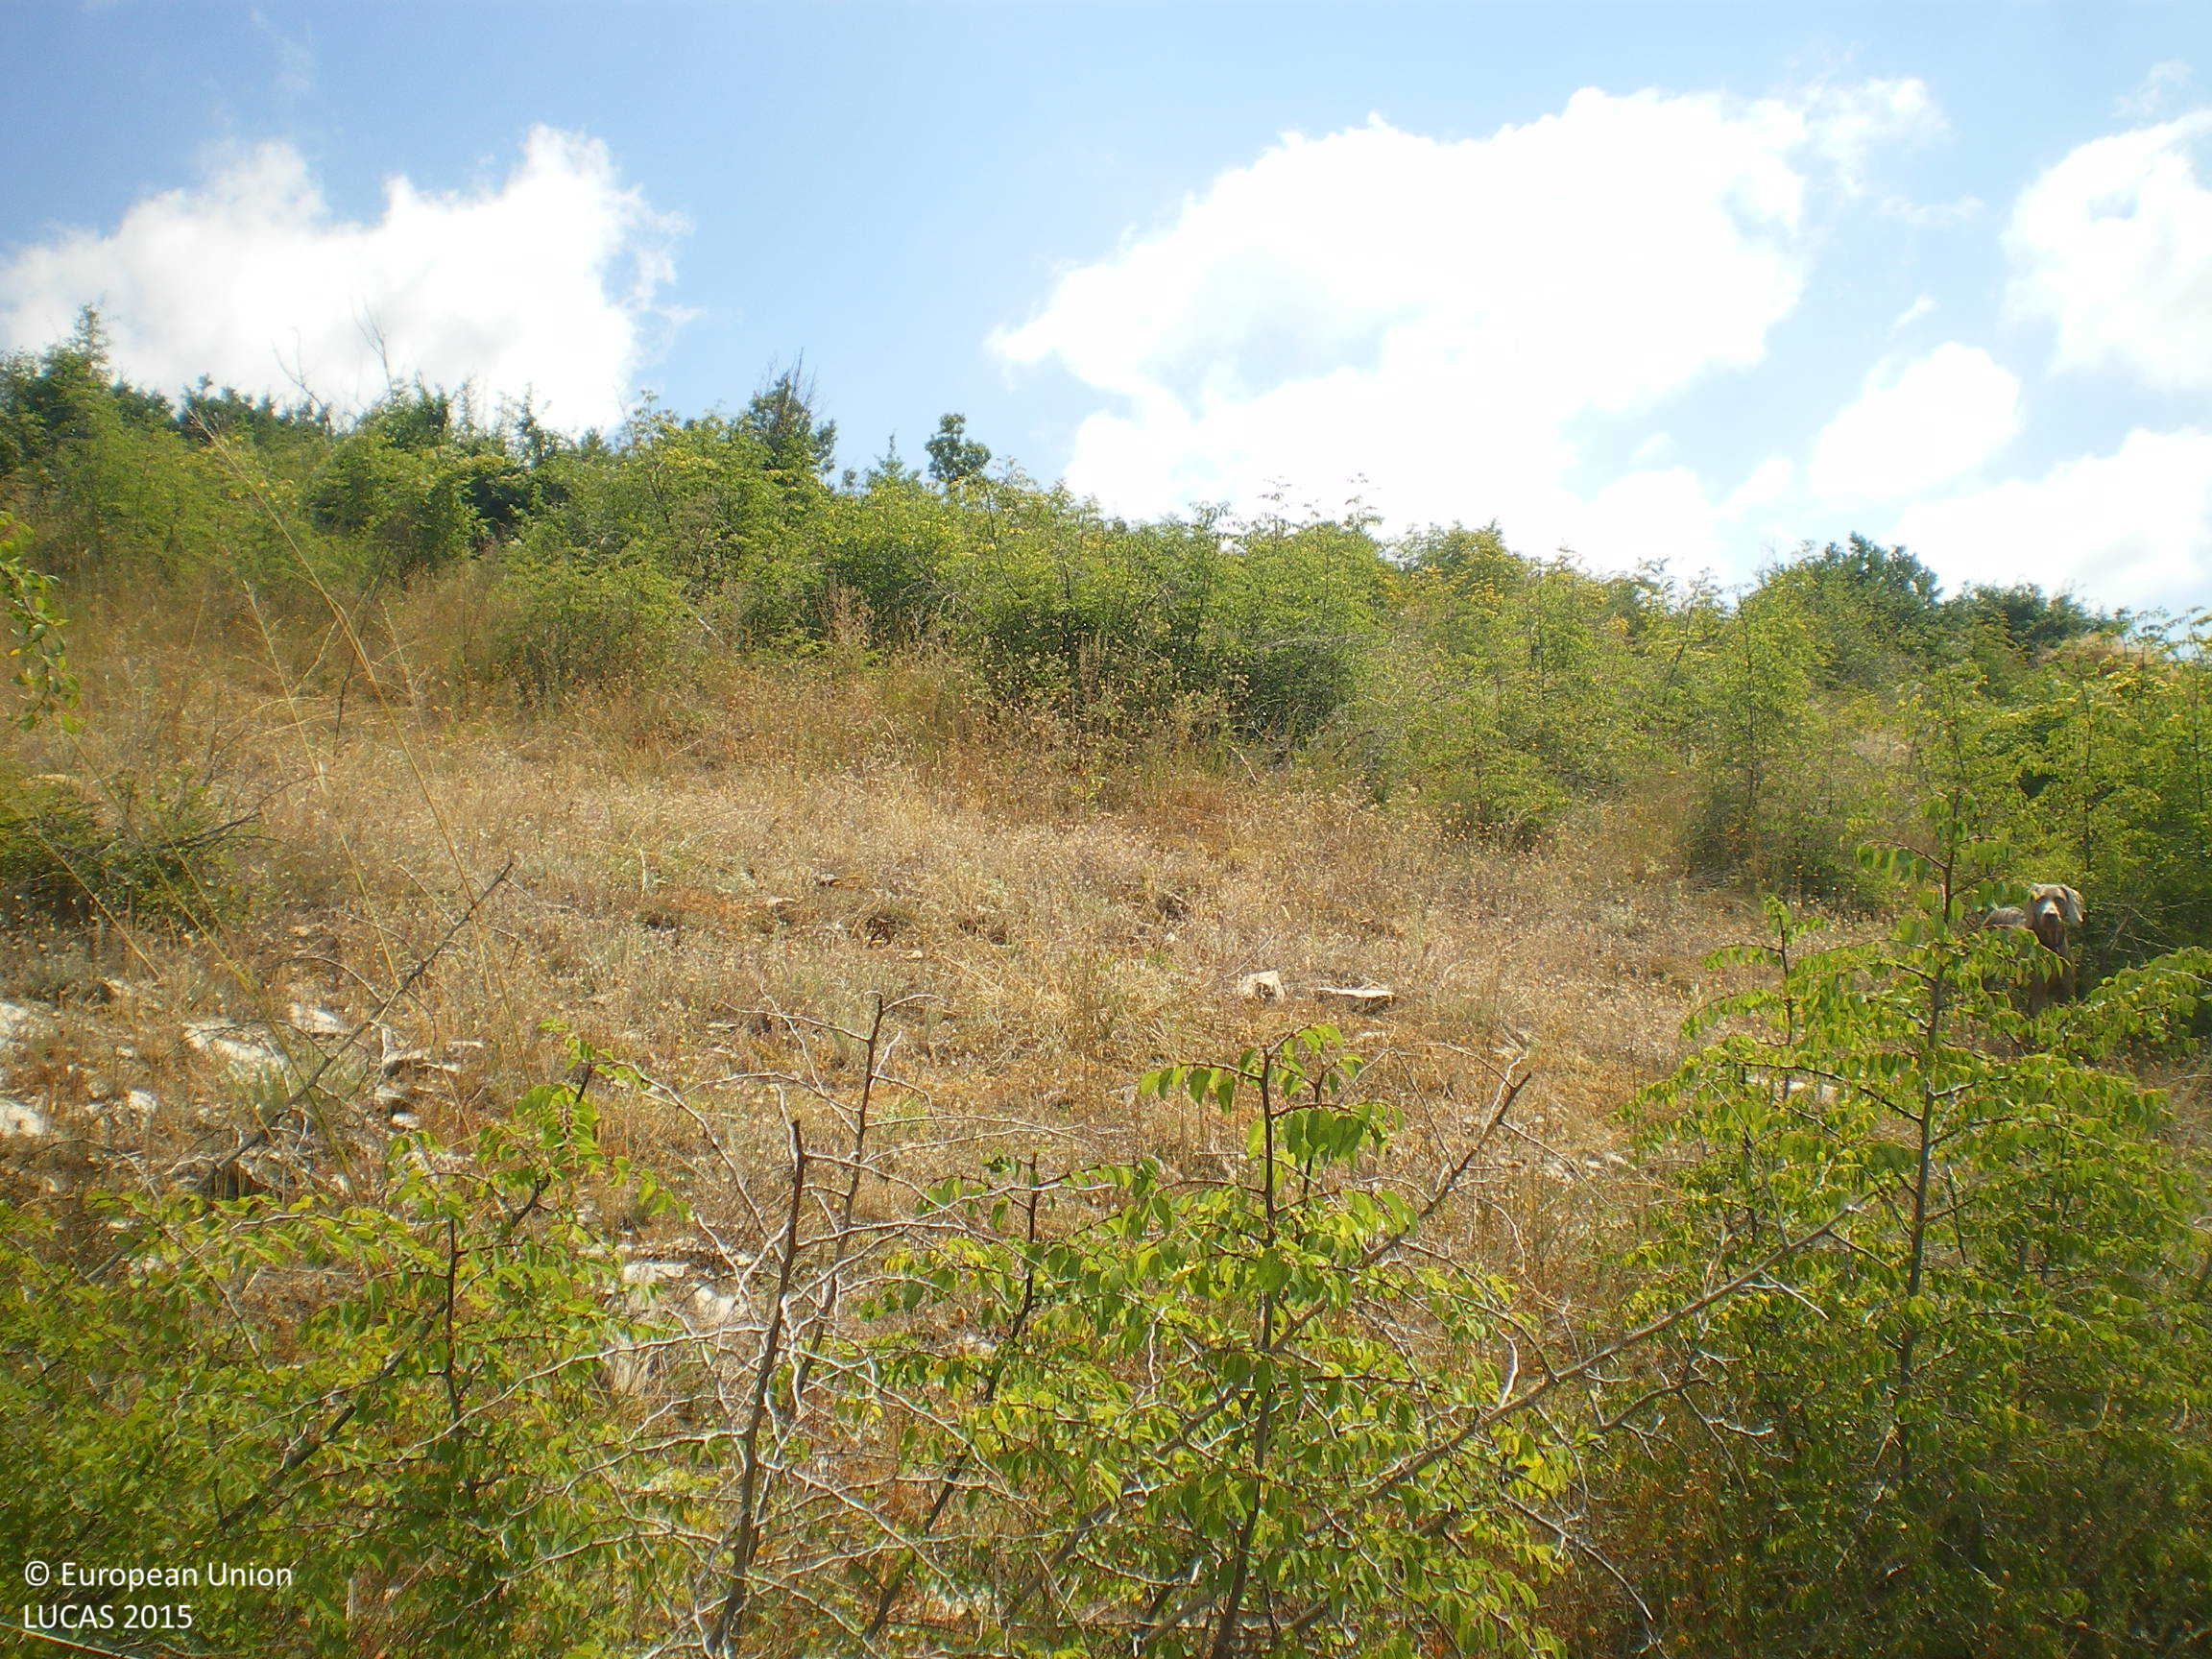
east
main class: Shrubland
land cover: Shrubland without tree cover
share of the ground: 10 - 25 %
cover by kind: herbaceous plants 90 %, shrubs 10 %
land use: Semi-natural and natural areas not in use
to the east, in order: Shrubland without tree cover; Grassland without tree/shrub cover; Shrubland without tree cover; Tracks; Grassland with sparse tree/shrub cover; Shrubland without tree cover; Grassland without tree/shrub cover; Tracks; Grassland with sparse tree/shrub cover; Grassland without tree/shrub cover; Tracks; Grassland without tree/shrub cover; Grassland with sparse tree/shrub cover
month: August
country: BG
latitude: 42.4328
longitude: 25.5690
